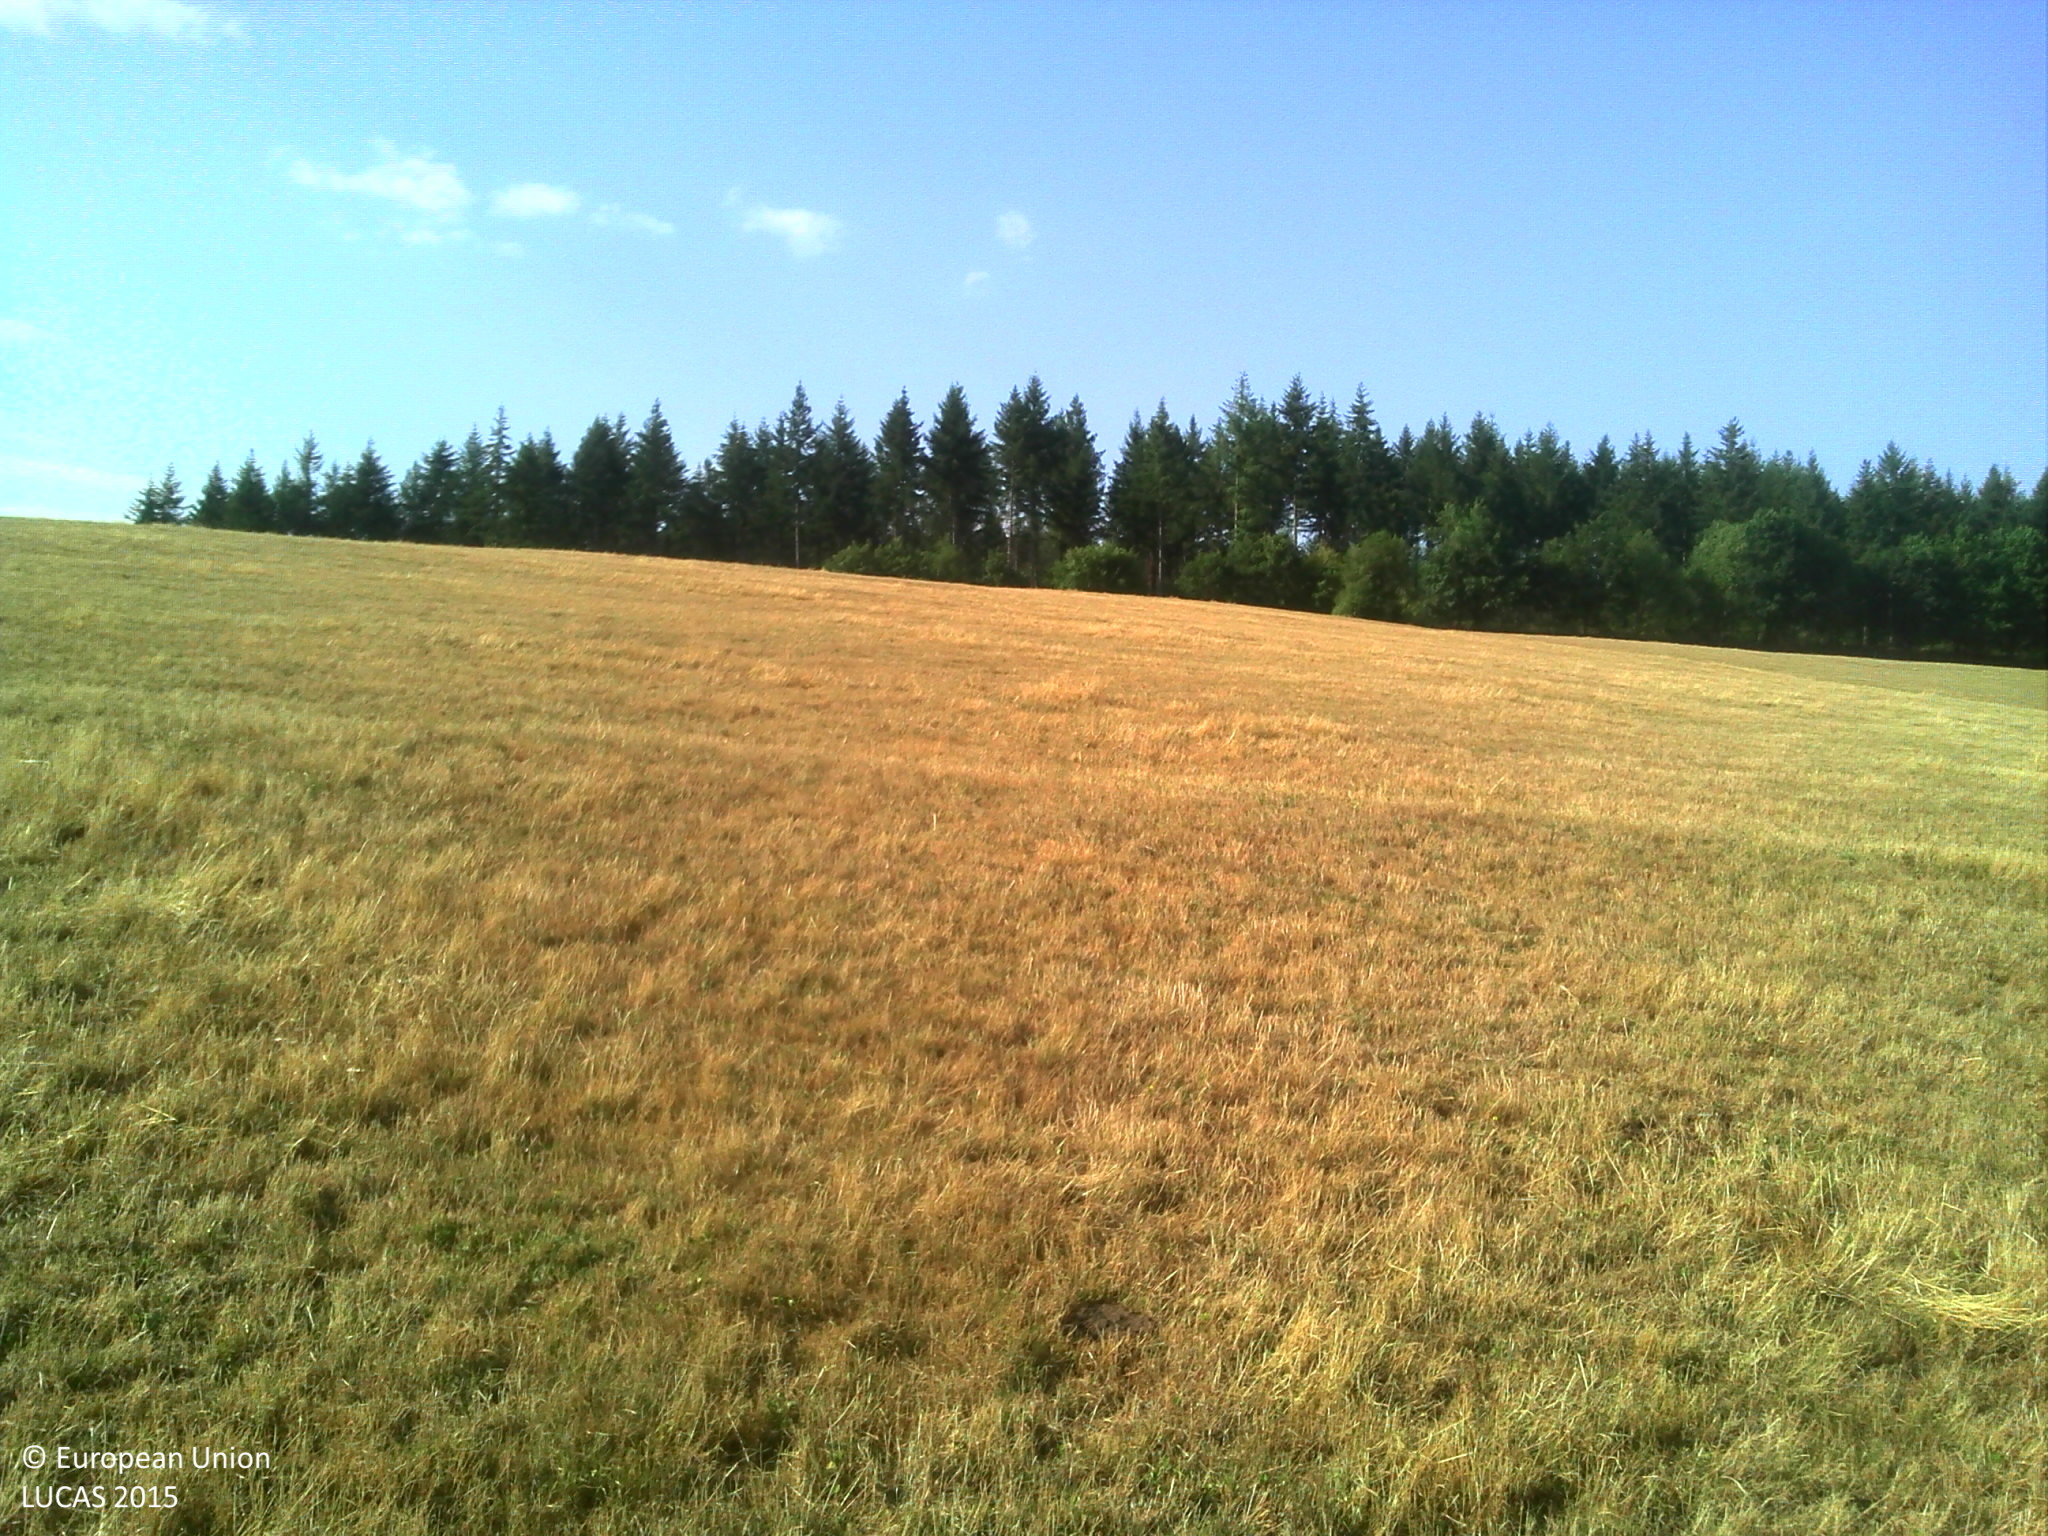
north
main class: Grassland
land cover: Grassland without tree/shrub cover
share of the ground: > 75 %
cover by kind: herbaceous plants 100 %
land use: Agriculture (excluding fallow land and kitchen gardens)
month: July
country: FR
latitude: 46.6183
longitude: 4.3725
